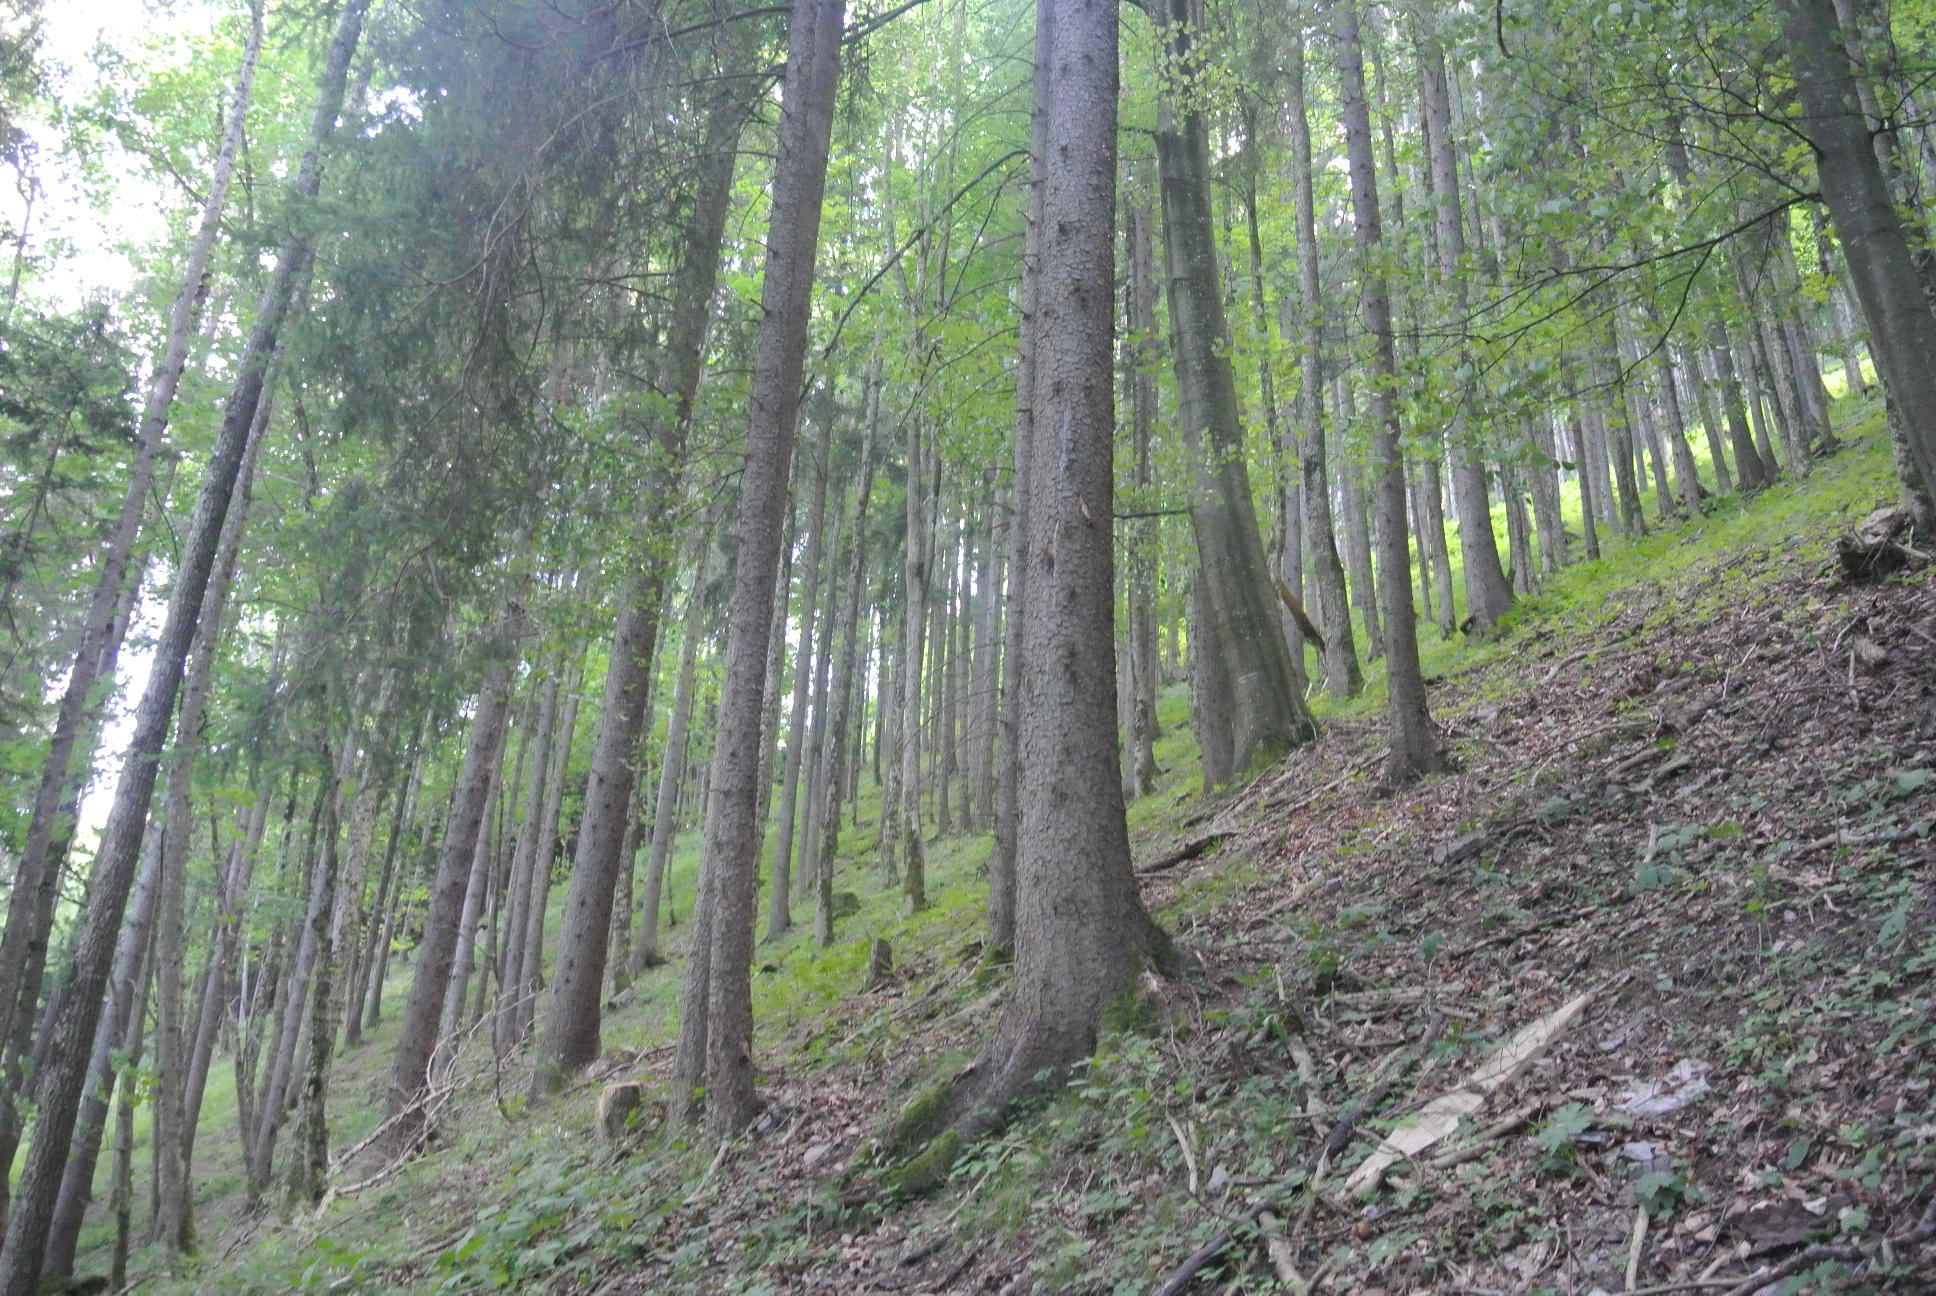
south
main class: Woodland
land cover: Spruce dominated mixed woodland
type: alpine coniferous forest
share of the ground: > 75 %
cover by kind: coniferous forest trees 75 %, broadleaved forest trees 25 %
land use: Forestry
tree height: > 5 m
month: July
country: AT
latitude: 47.9557
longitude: 15.5862
